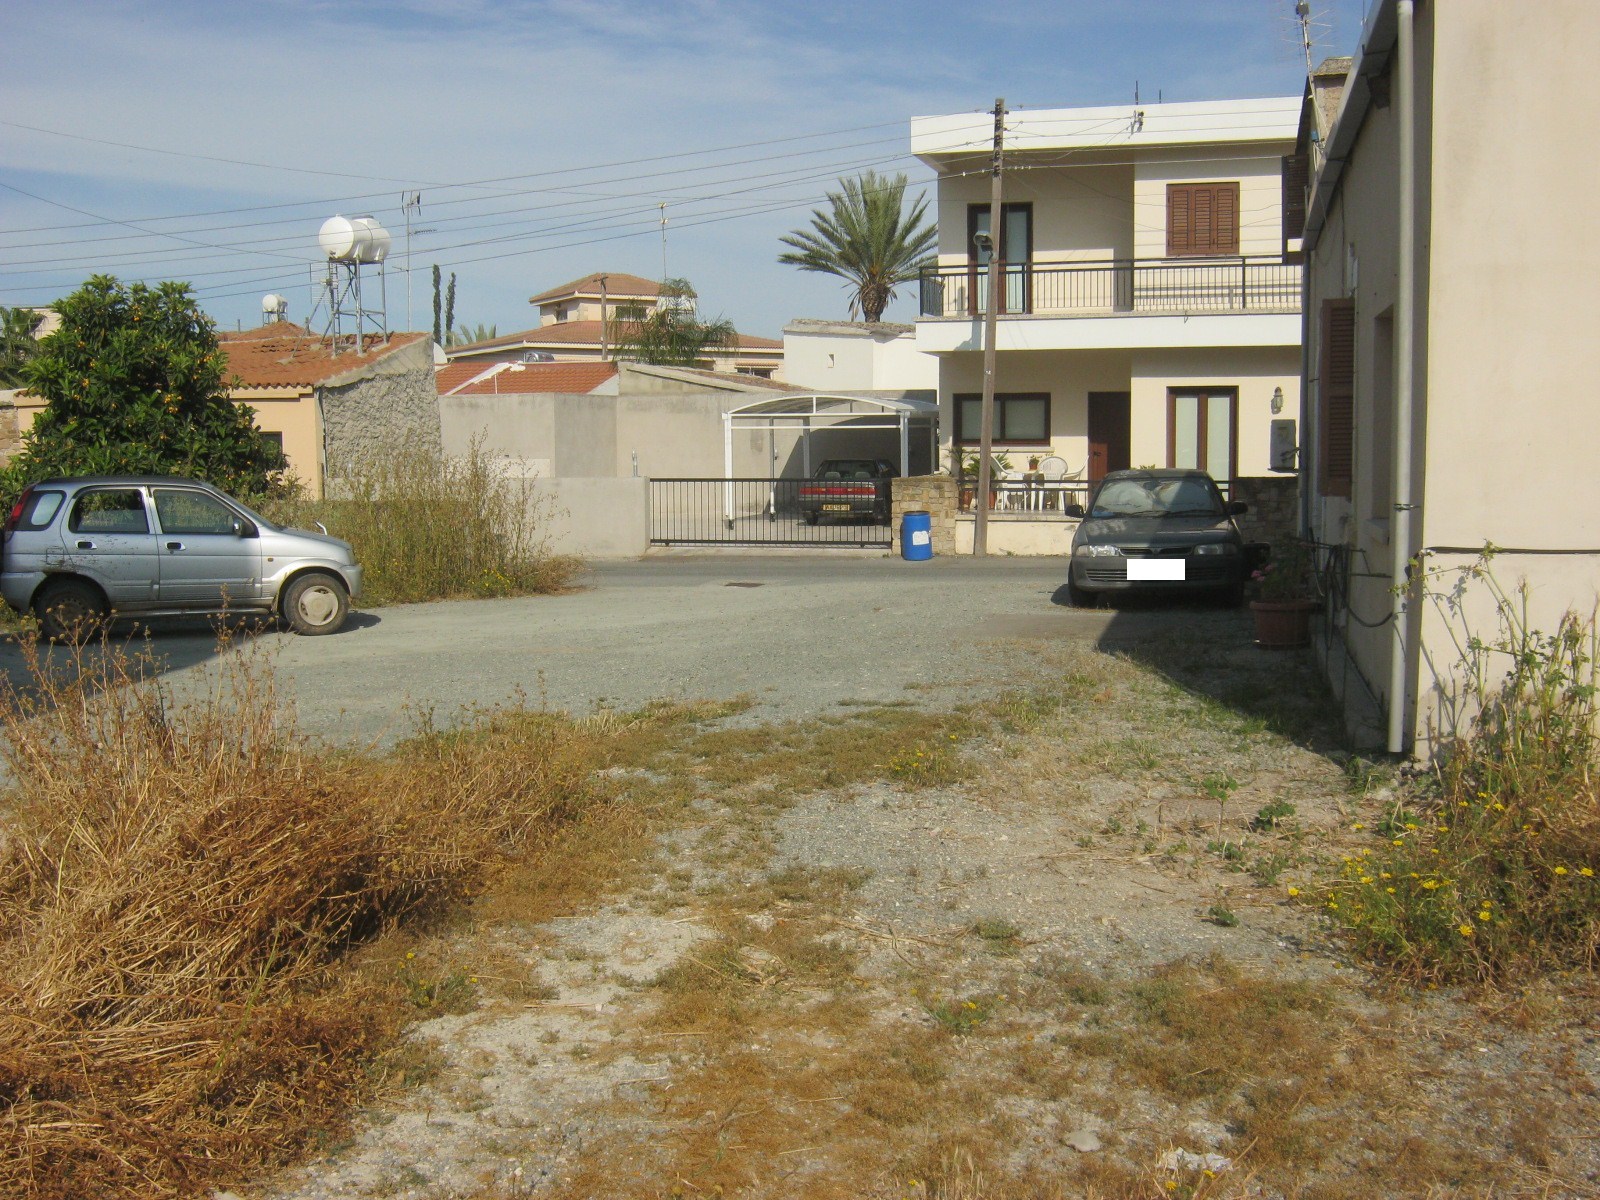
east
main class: Grassland
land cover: Grassland without tree/shrub cover
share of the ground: > 75 %
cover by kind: herbaceous plants 90 %, unconsolidated bare surface 10 %
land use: Residential
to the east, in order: Grassland without tree/shrub cover; Other bare soil; Artificial constructions in urban areas
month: May
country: CY
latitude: 35.0127
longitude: 33.3888
